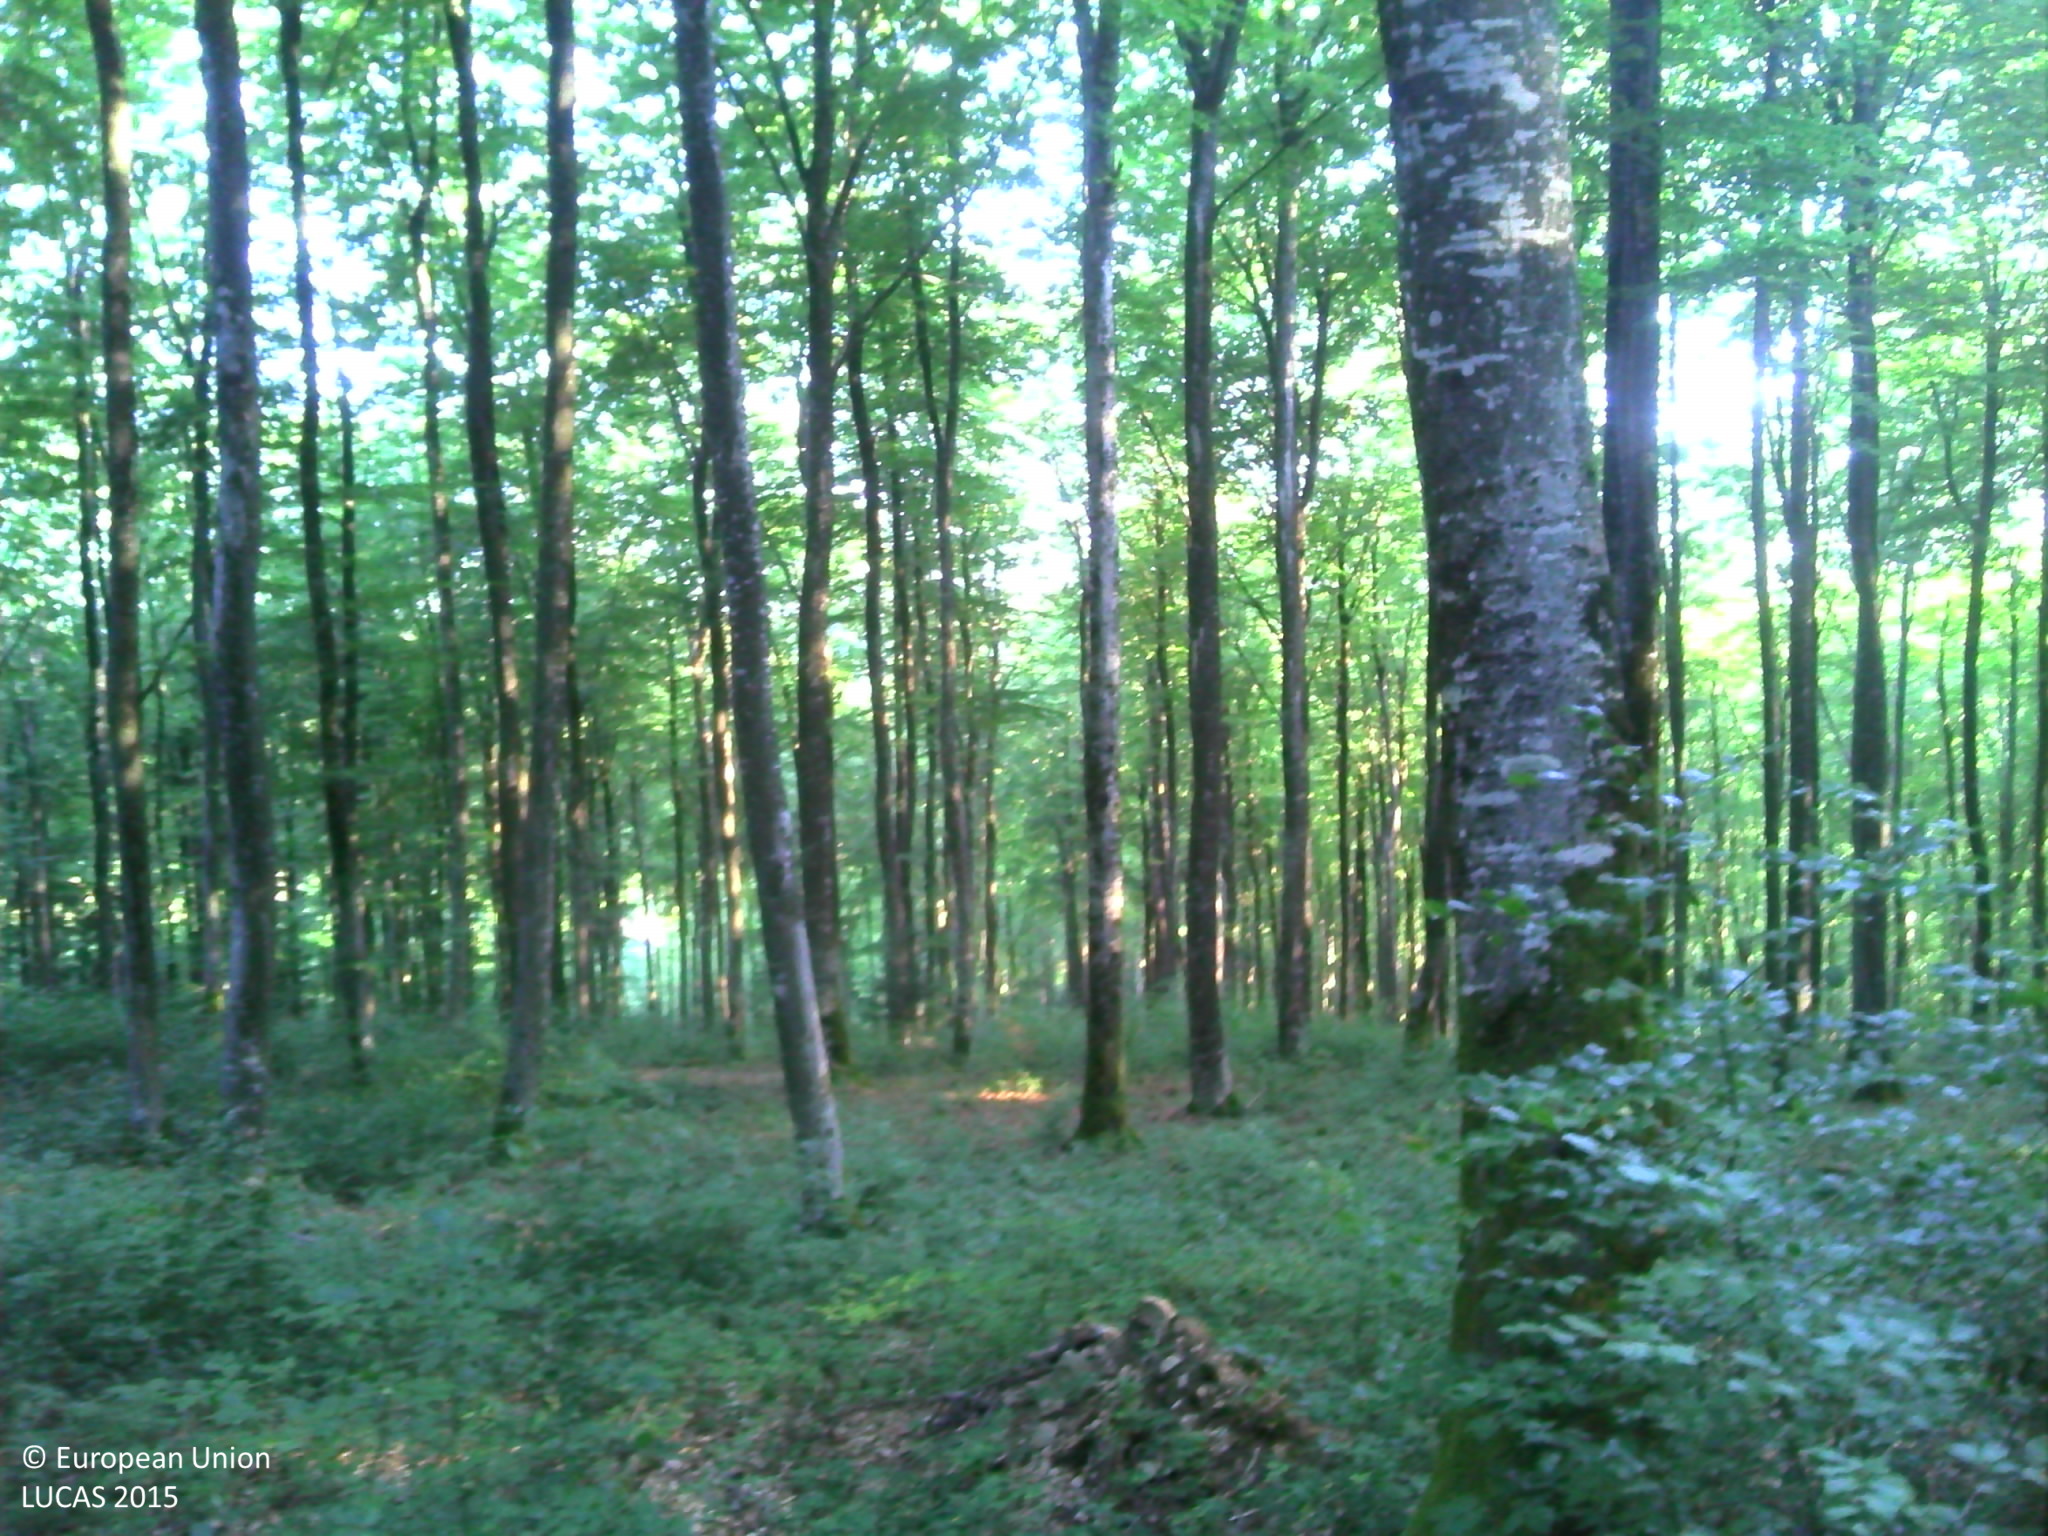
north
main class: Woodland
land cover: Broadleaved woodland
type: beech forest
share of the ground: > 75 %
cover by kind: broadleaved forest trees 75 %, herbaceous plants 25 %
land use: Forestry
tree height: > 5 m
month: August
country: FR
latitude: 46.8709
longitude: 4.3719
